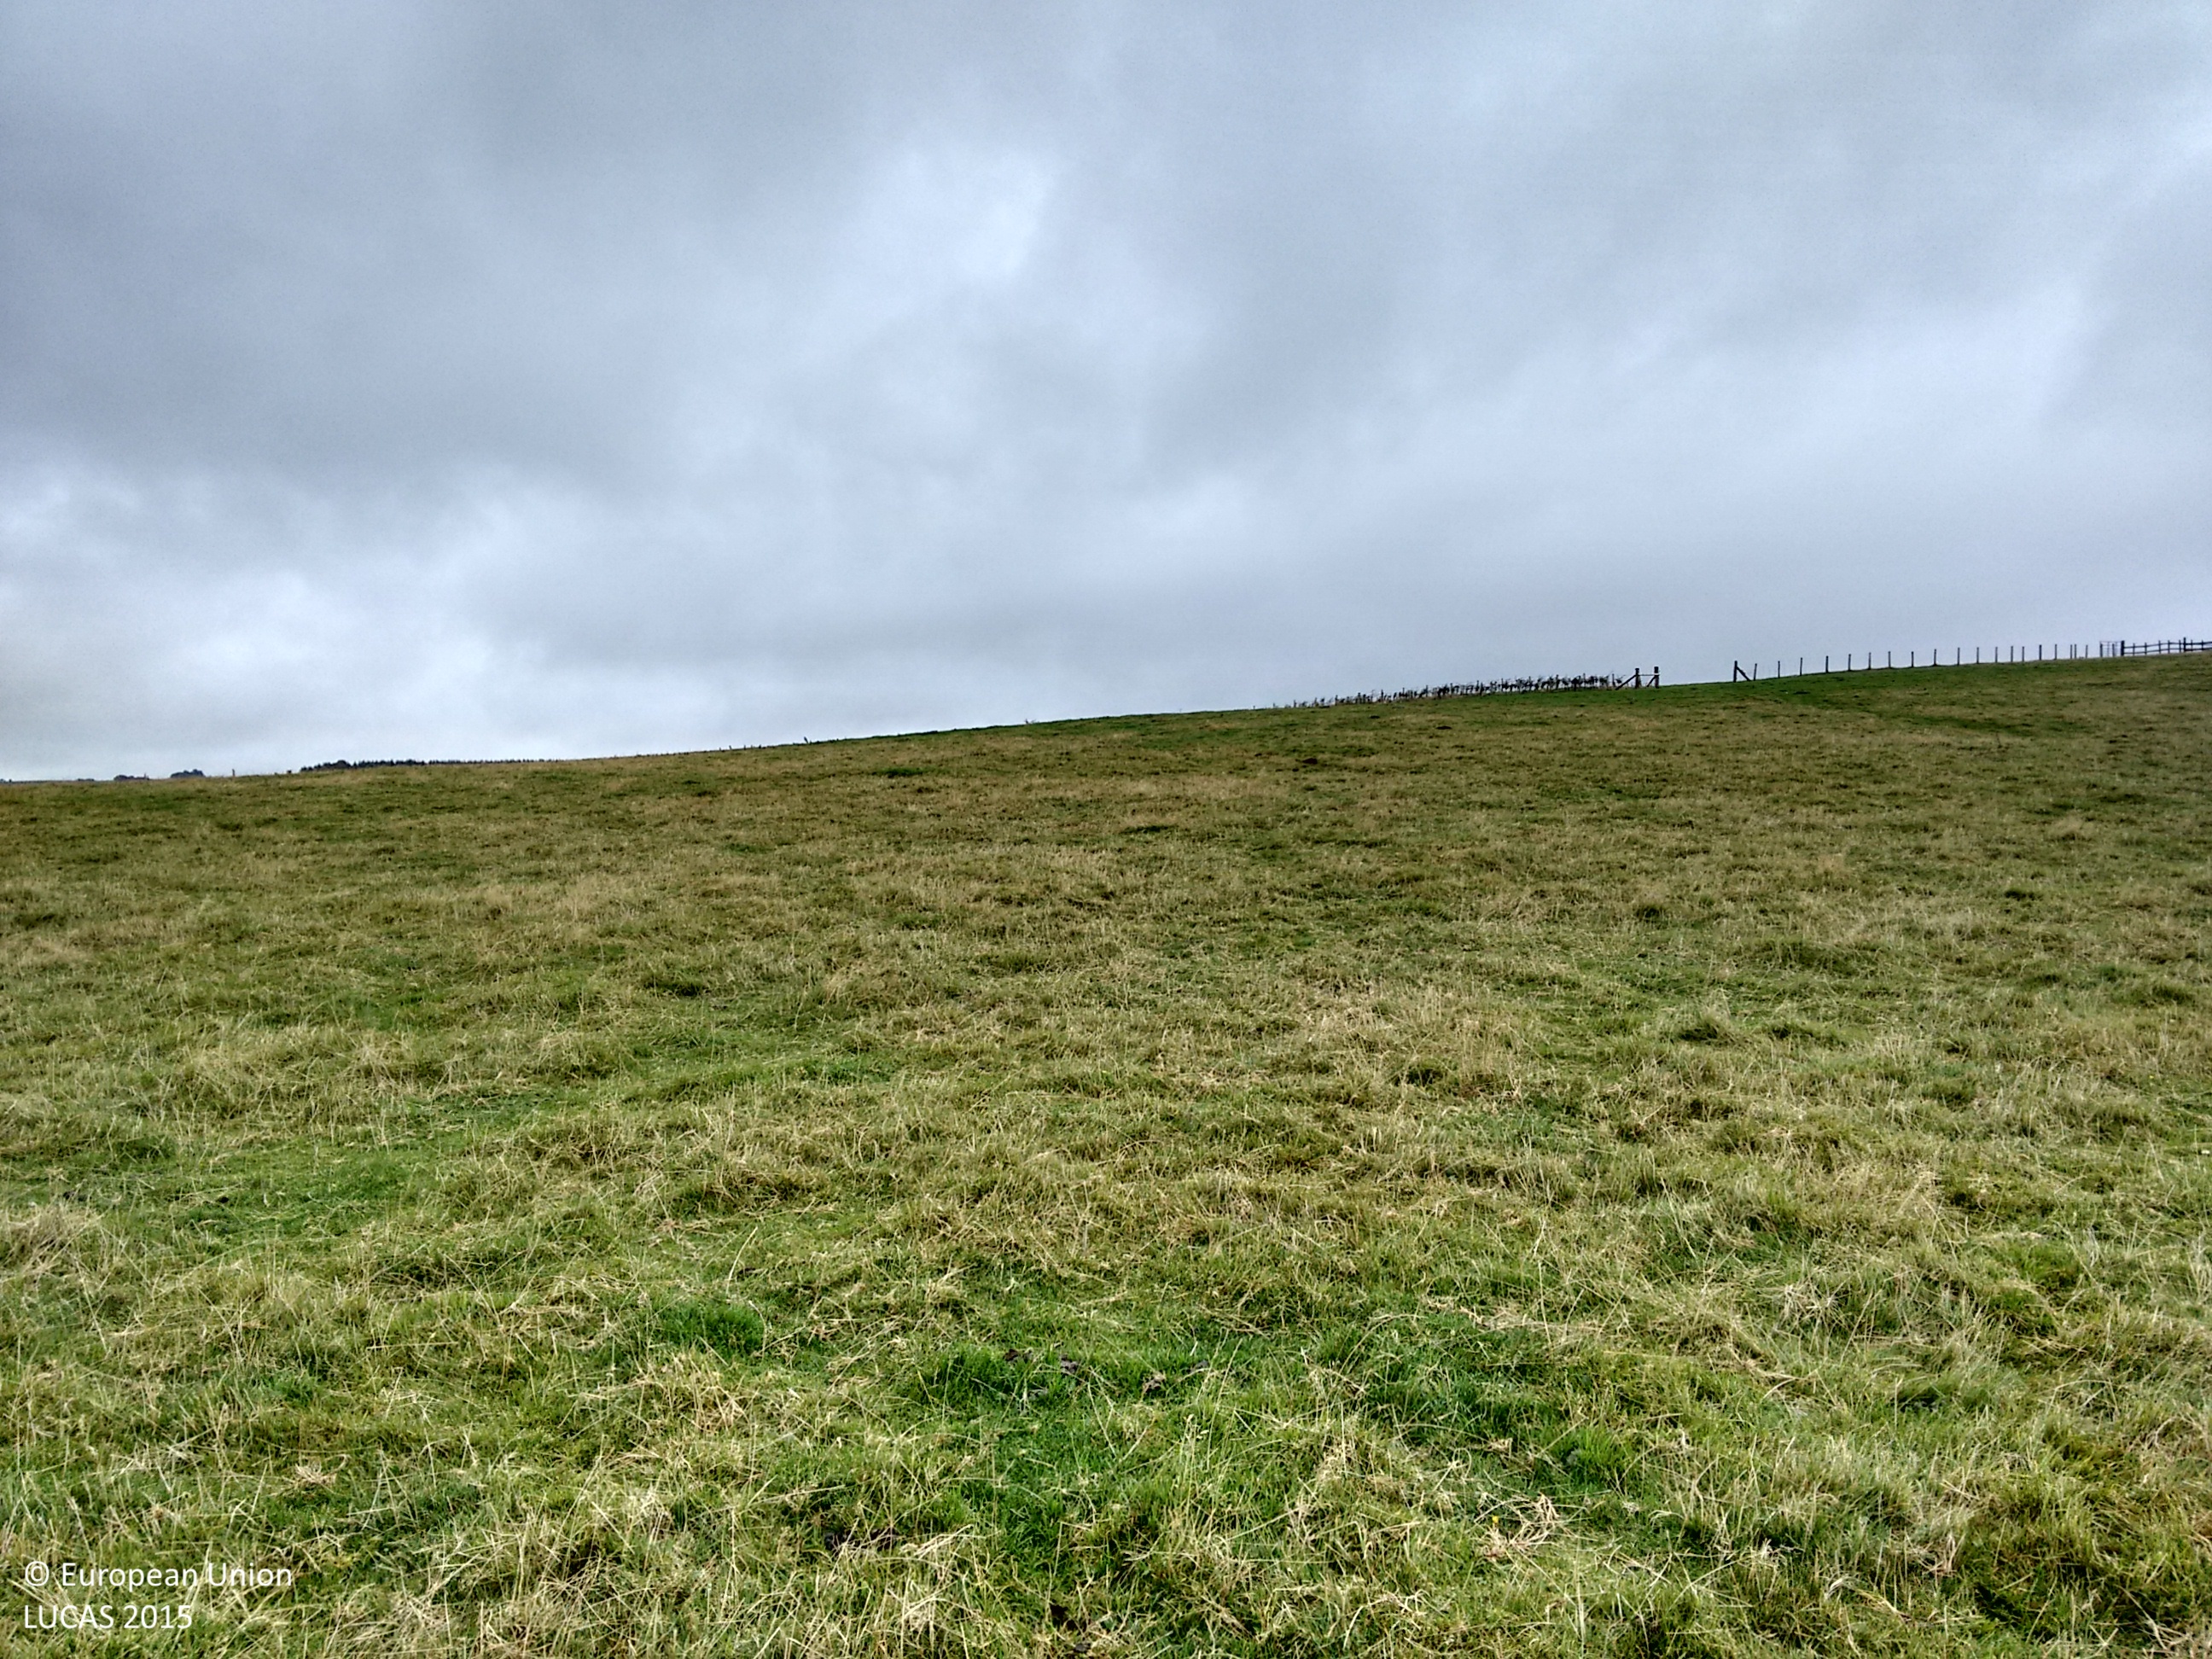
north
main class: Grassland
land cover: Grassland without tree/shrub cover
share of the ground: > 75 %
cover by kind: herbaceous plants 100 %
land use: Agriculture (excluding fallow land and kitchen gardens)
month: October
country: GB
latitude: 52.4365
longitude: -3.2146
